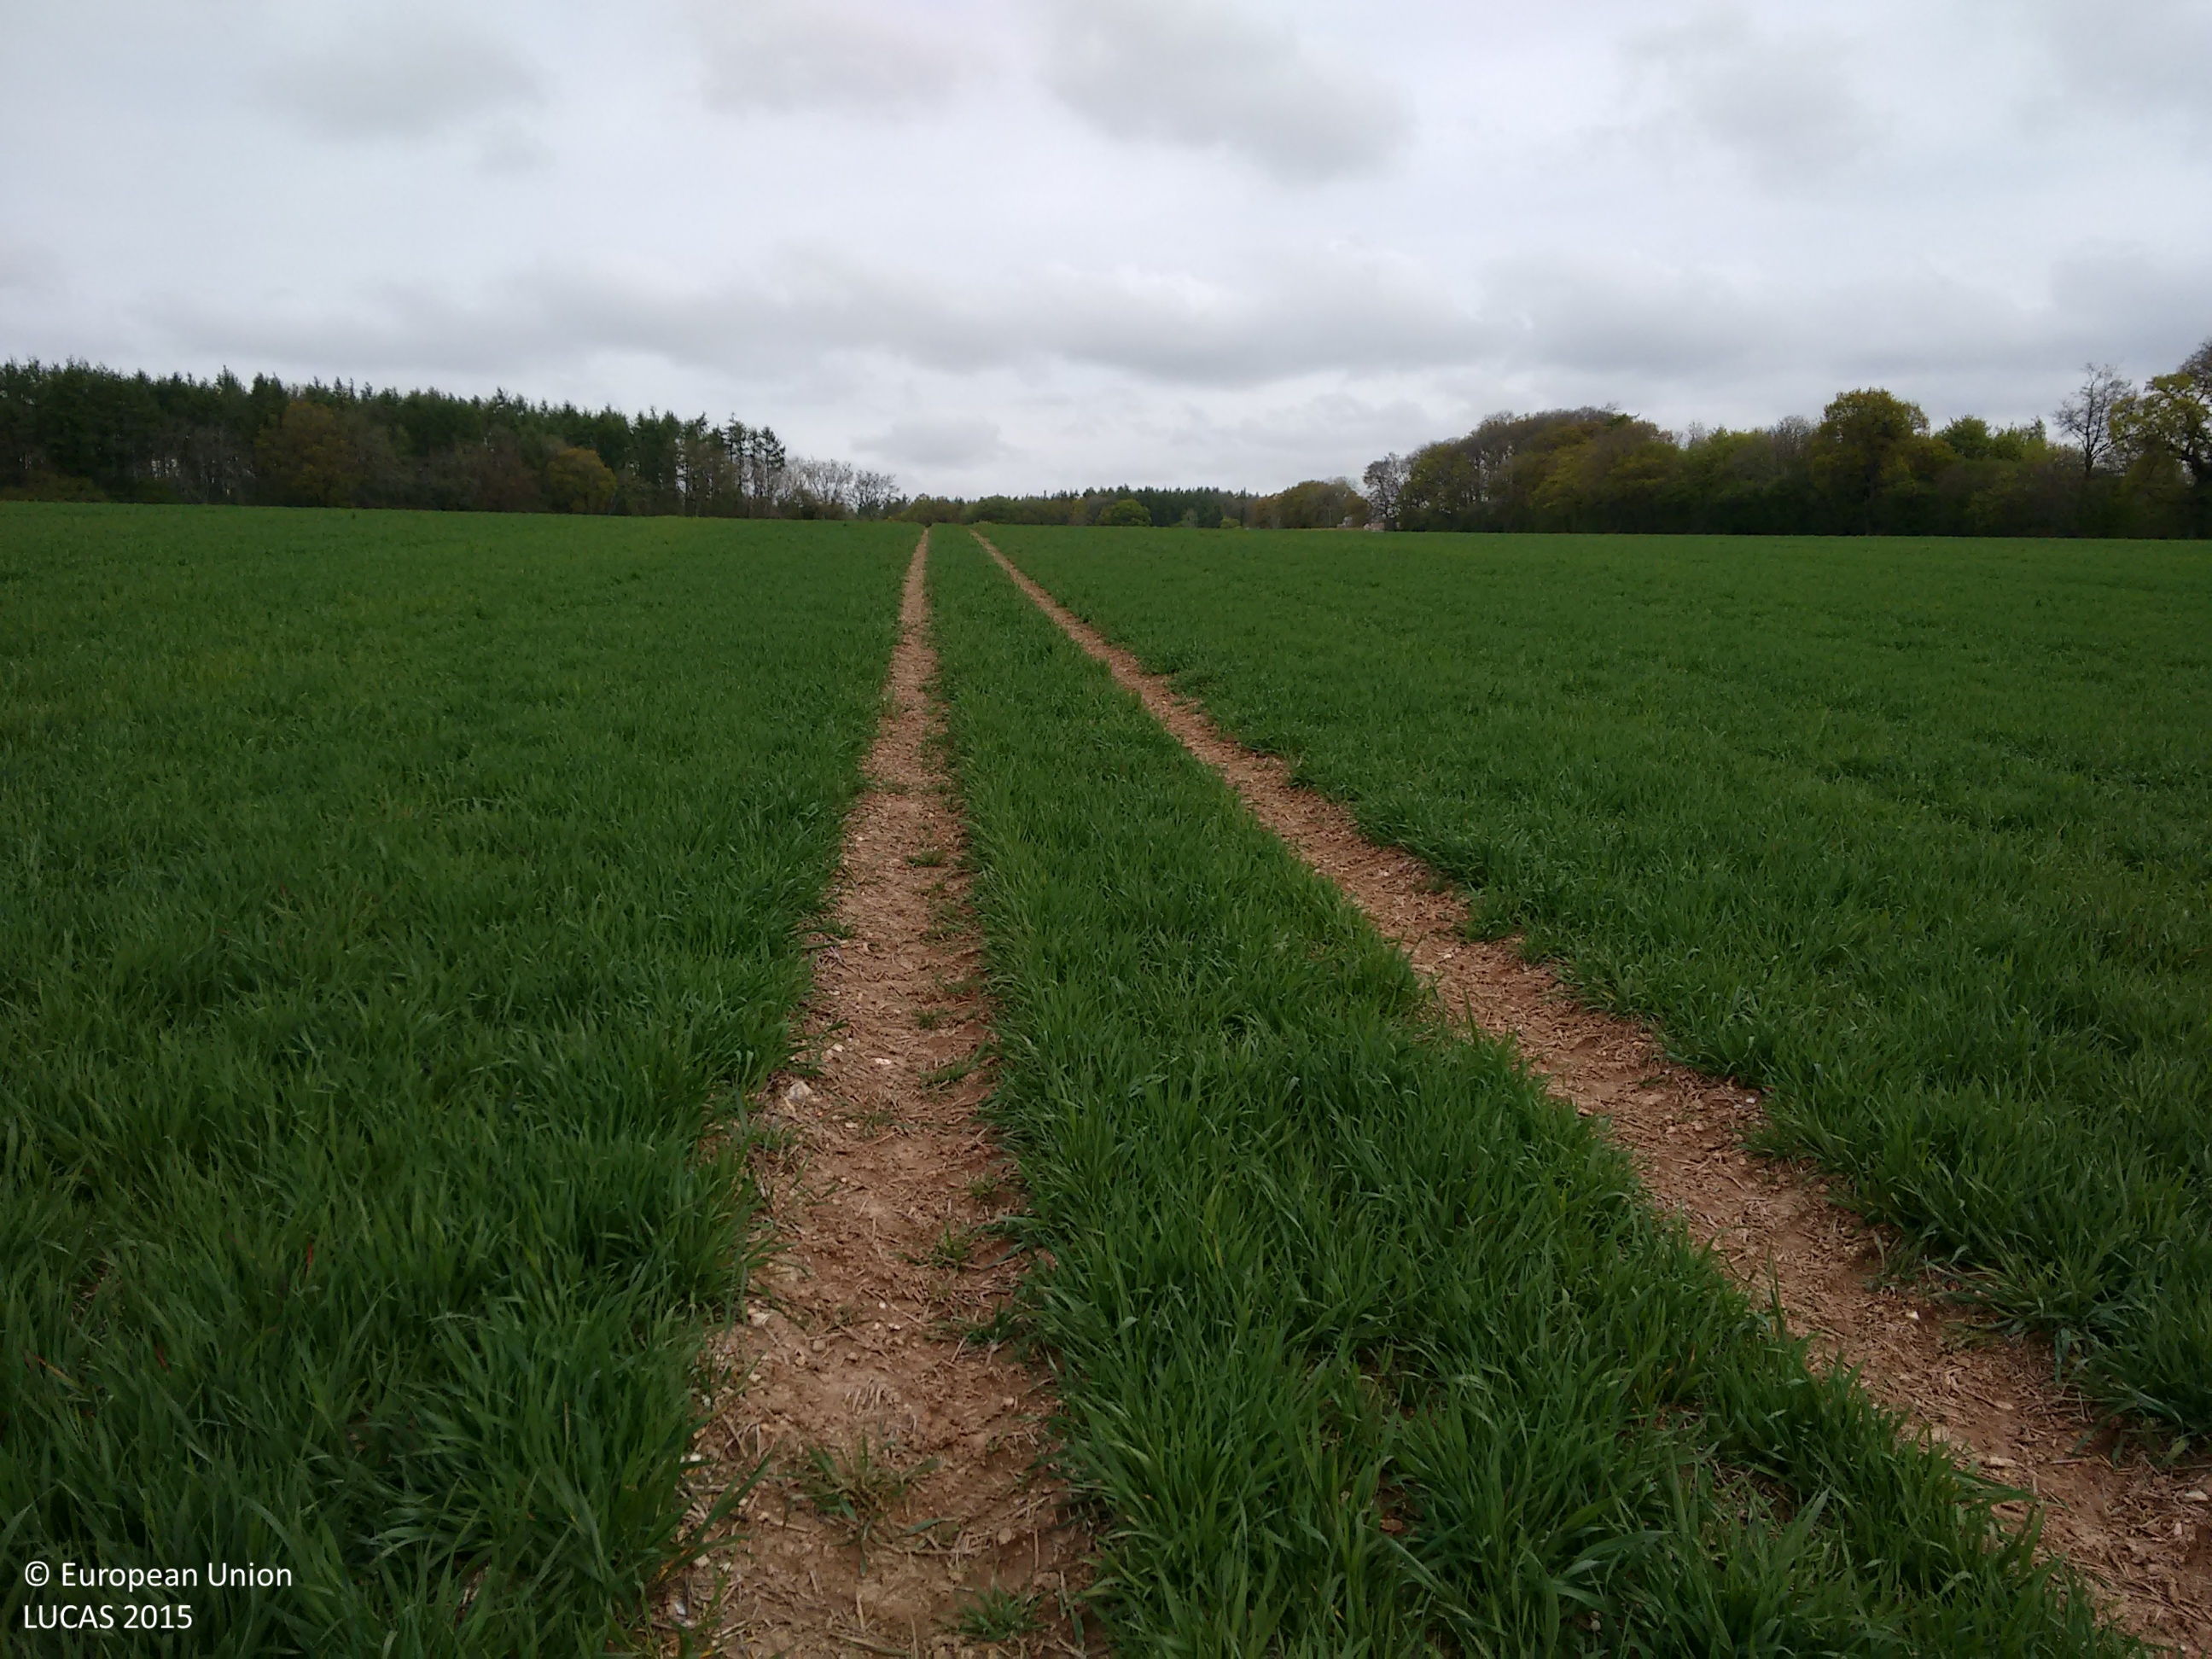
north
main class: Cropland
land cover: Oats
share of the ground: 50 - 75 %
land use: Agriculture (excluding fallow land and kitchen gardens)
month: May
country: GB
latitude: 51.1584
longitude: -0.9826
